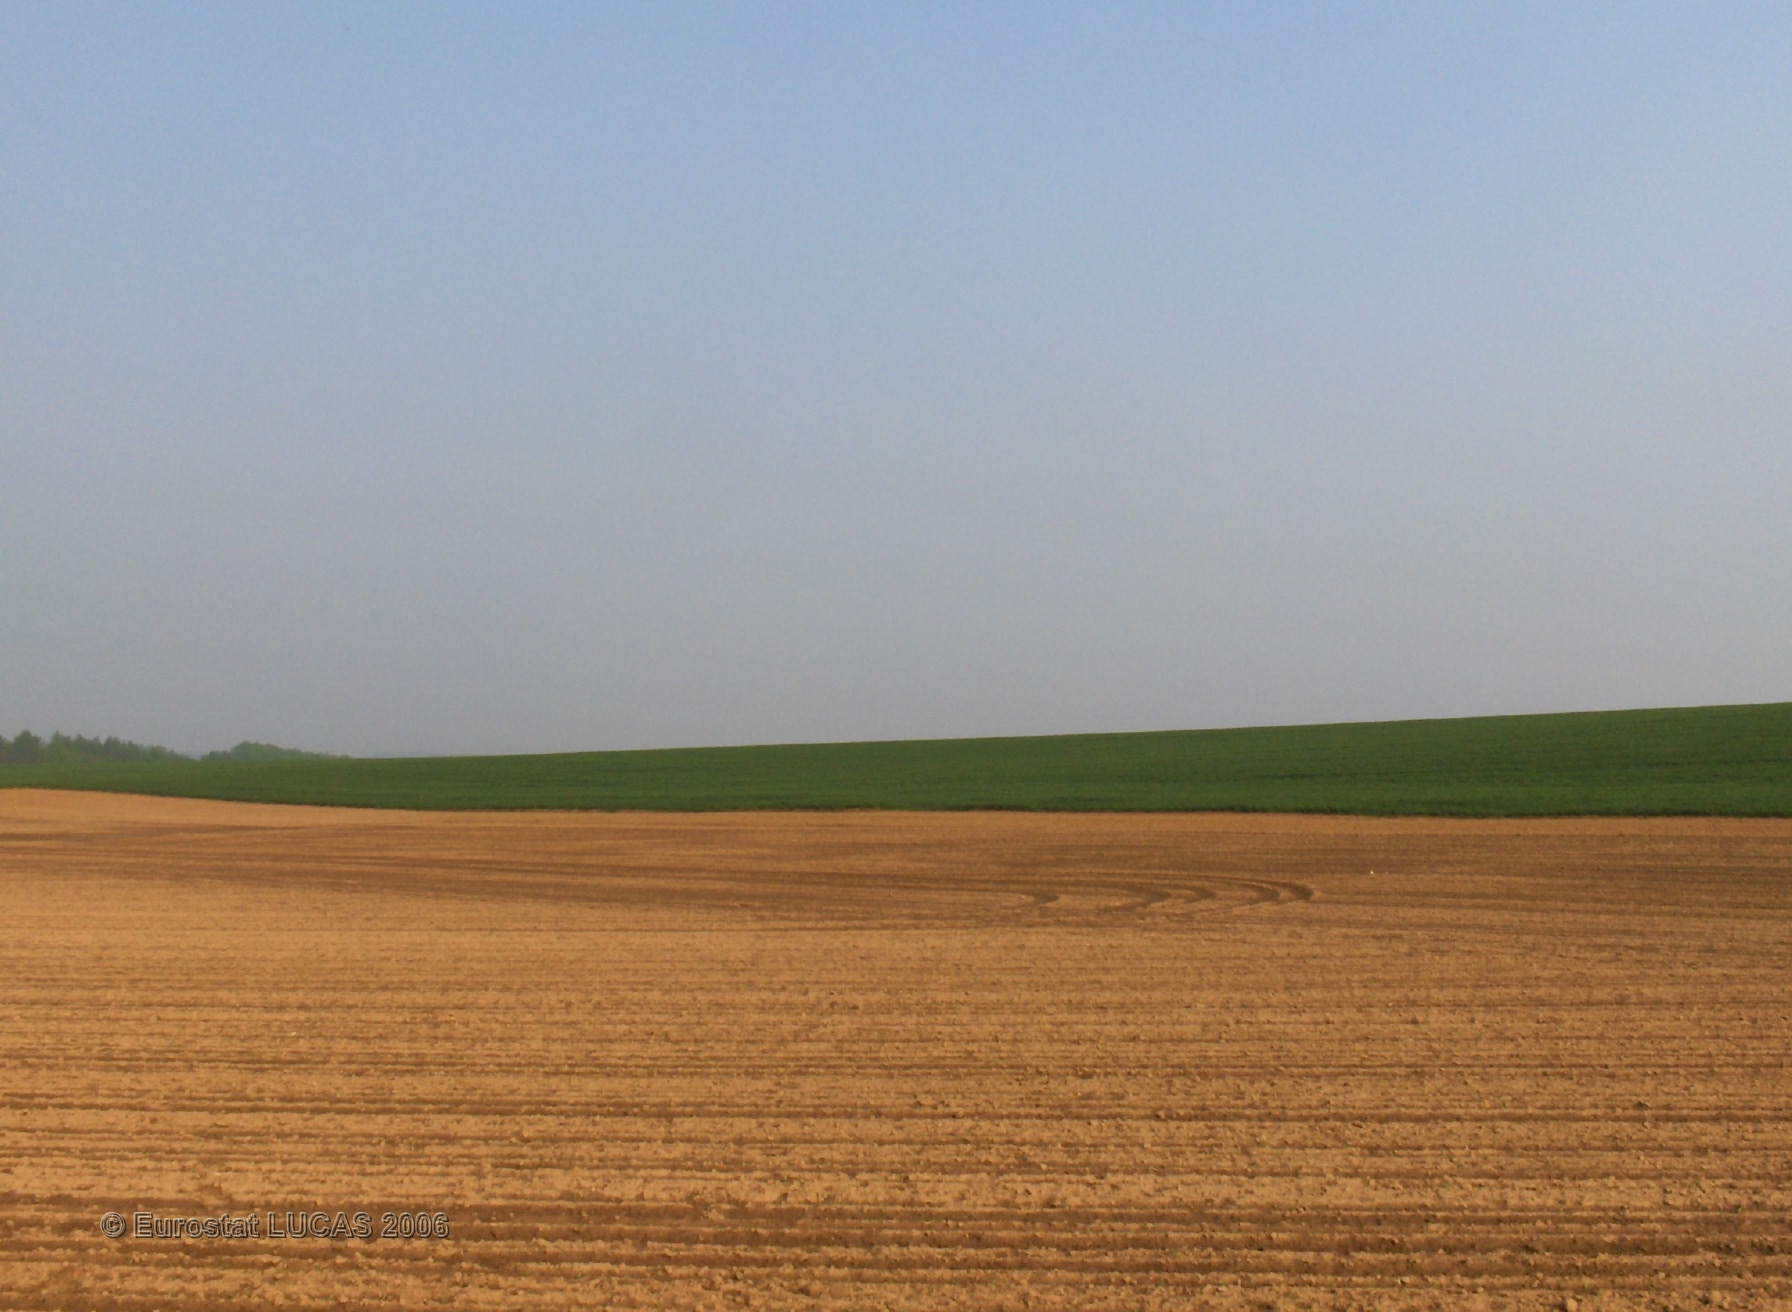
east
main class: Cropland
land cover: Sugar beet
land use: Agriculture (excluding fallow land and kitchen gardens)
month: May
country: BE
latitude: 50.6832
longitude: 4.5185
